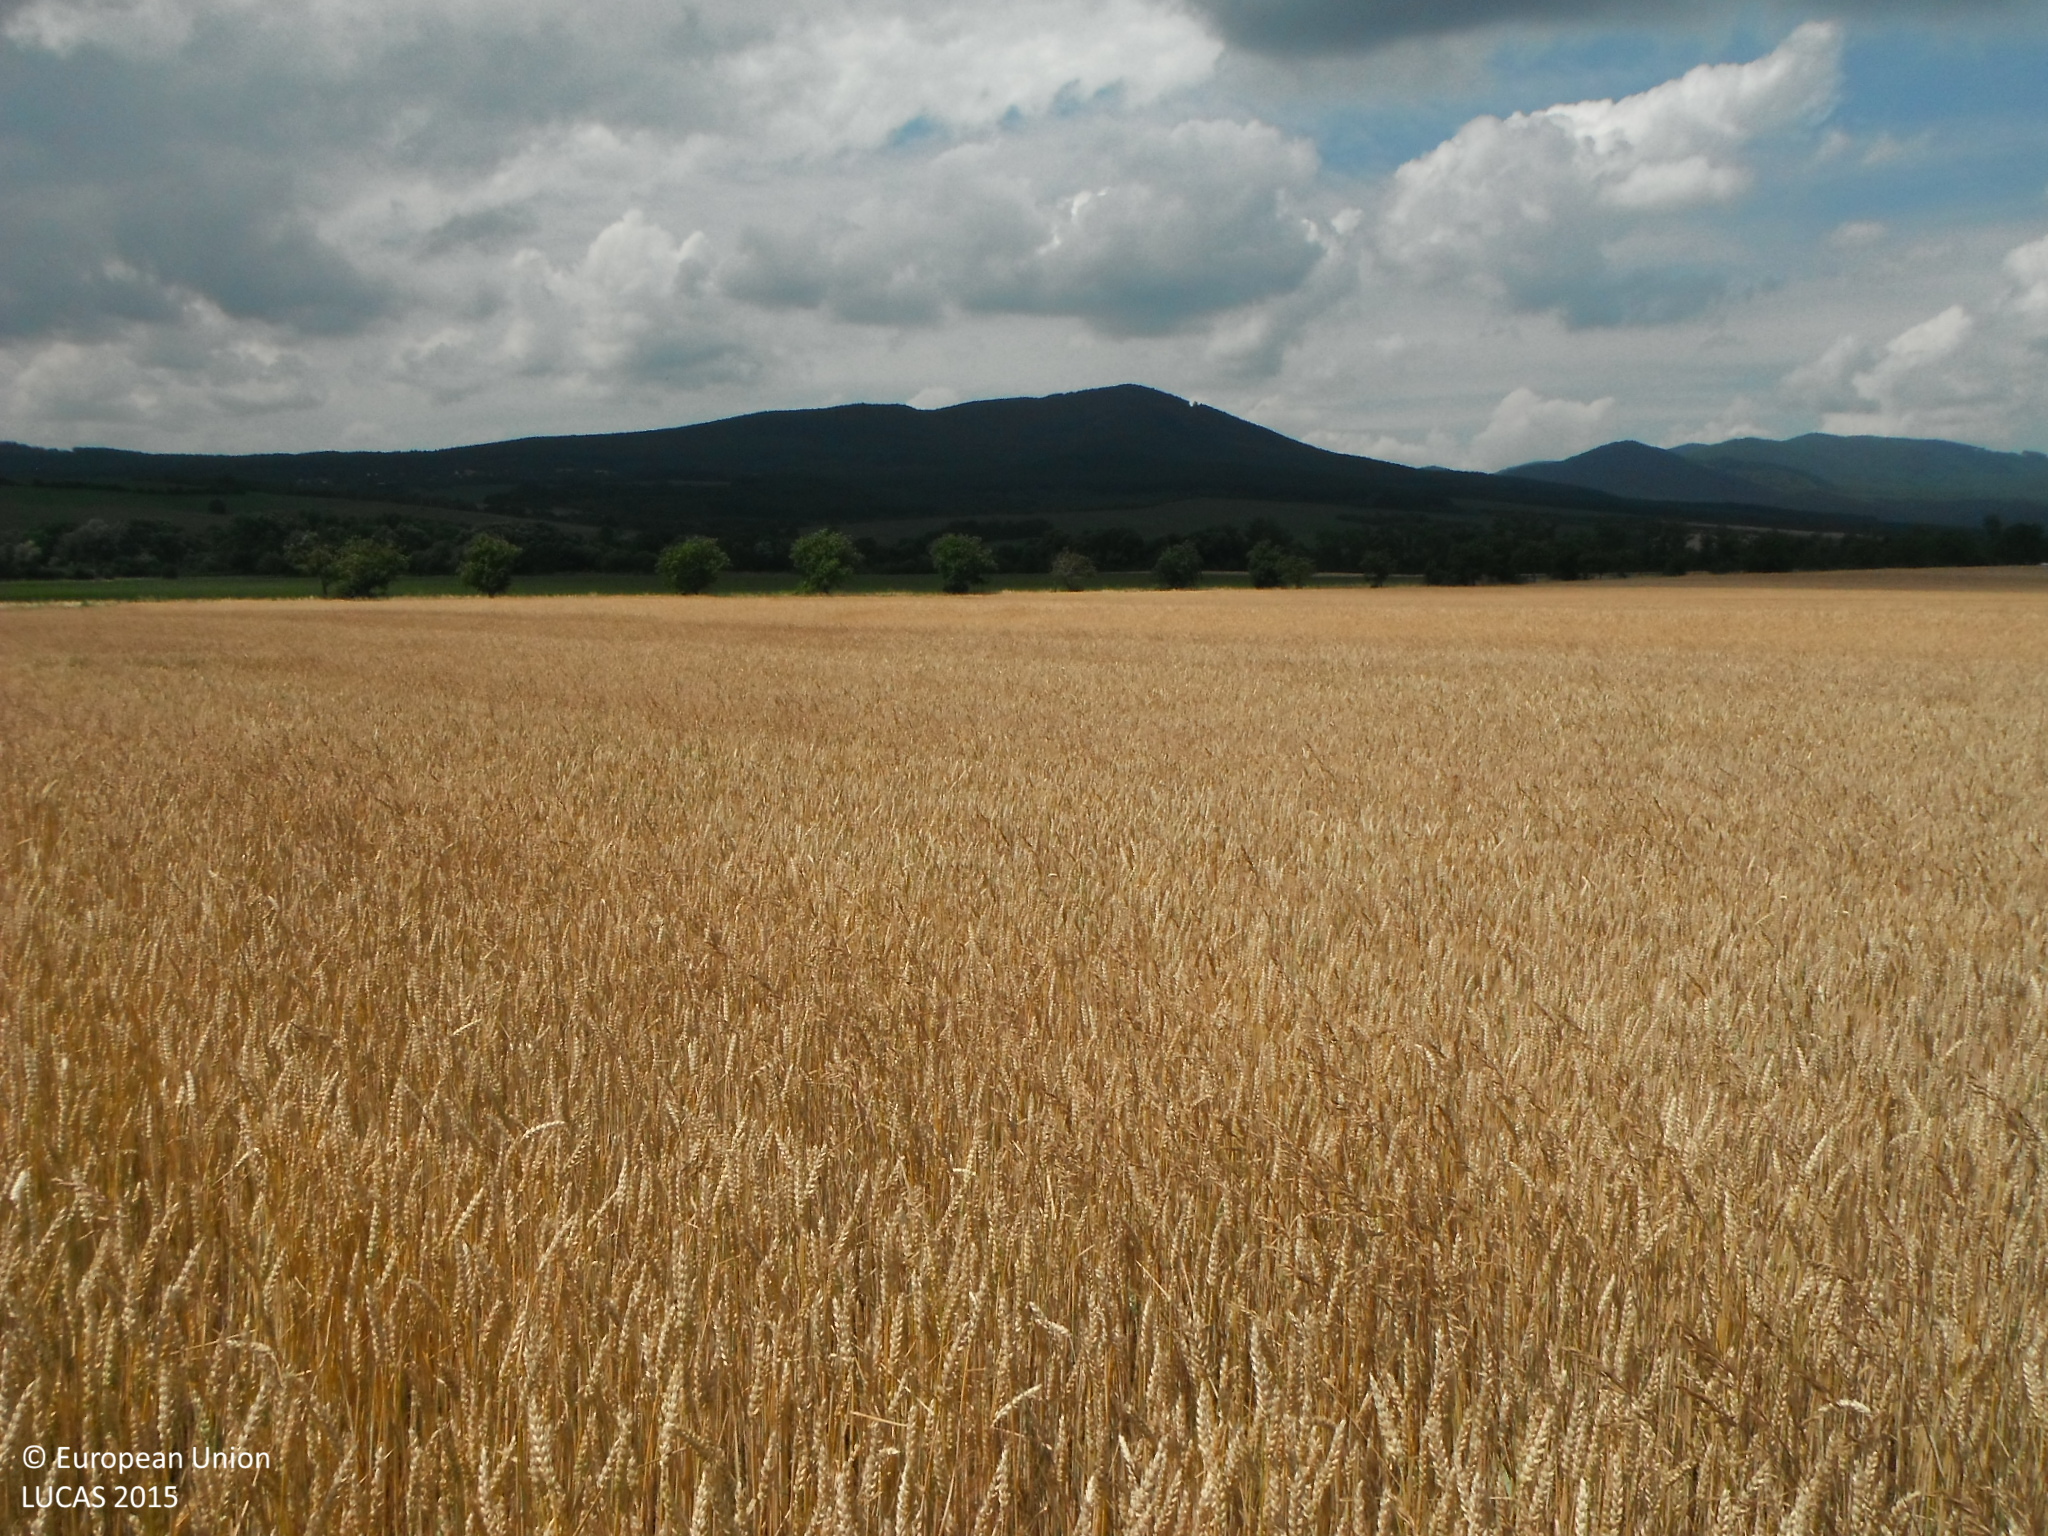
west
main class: Cropland
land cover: Common wheat
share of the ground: > 75 %
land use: Agriculture (excluding fallow land and kitchen gardens)
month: June
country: SK
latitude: 48.5386
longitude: 21.5741
